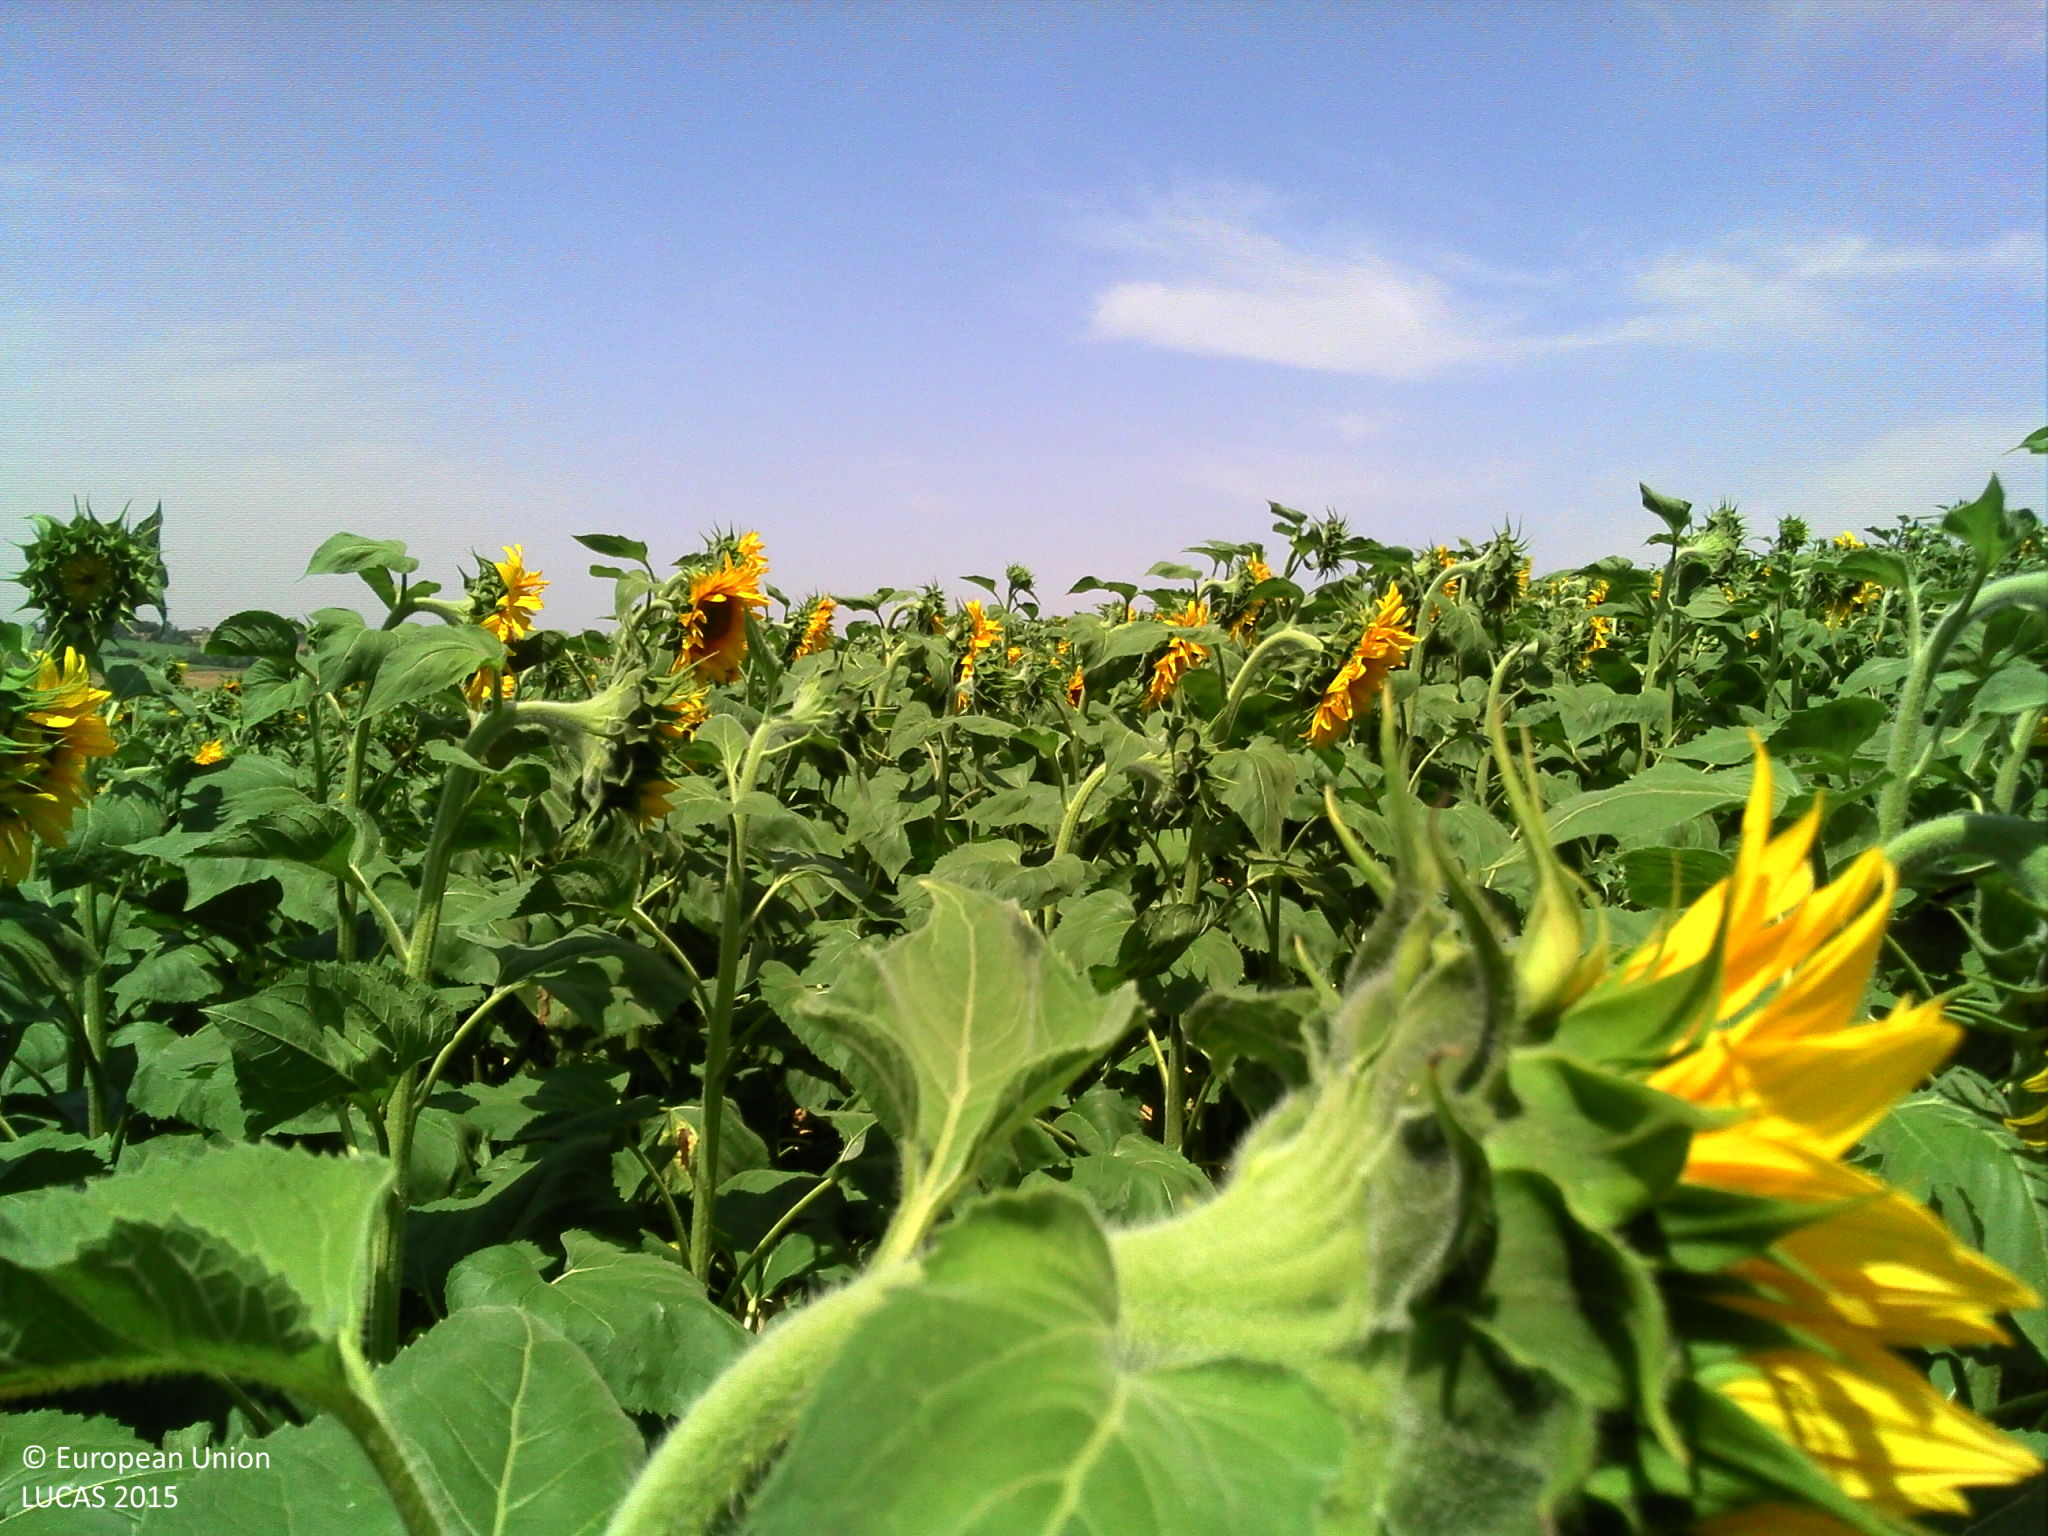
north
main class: Cropland
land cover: Sunflower
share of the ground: > 75 %
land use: Agriculture (excluding fallow land and kitchen gardens)
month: July
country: FR
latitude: 43.5082
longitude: 1.0335
